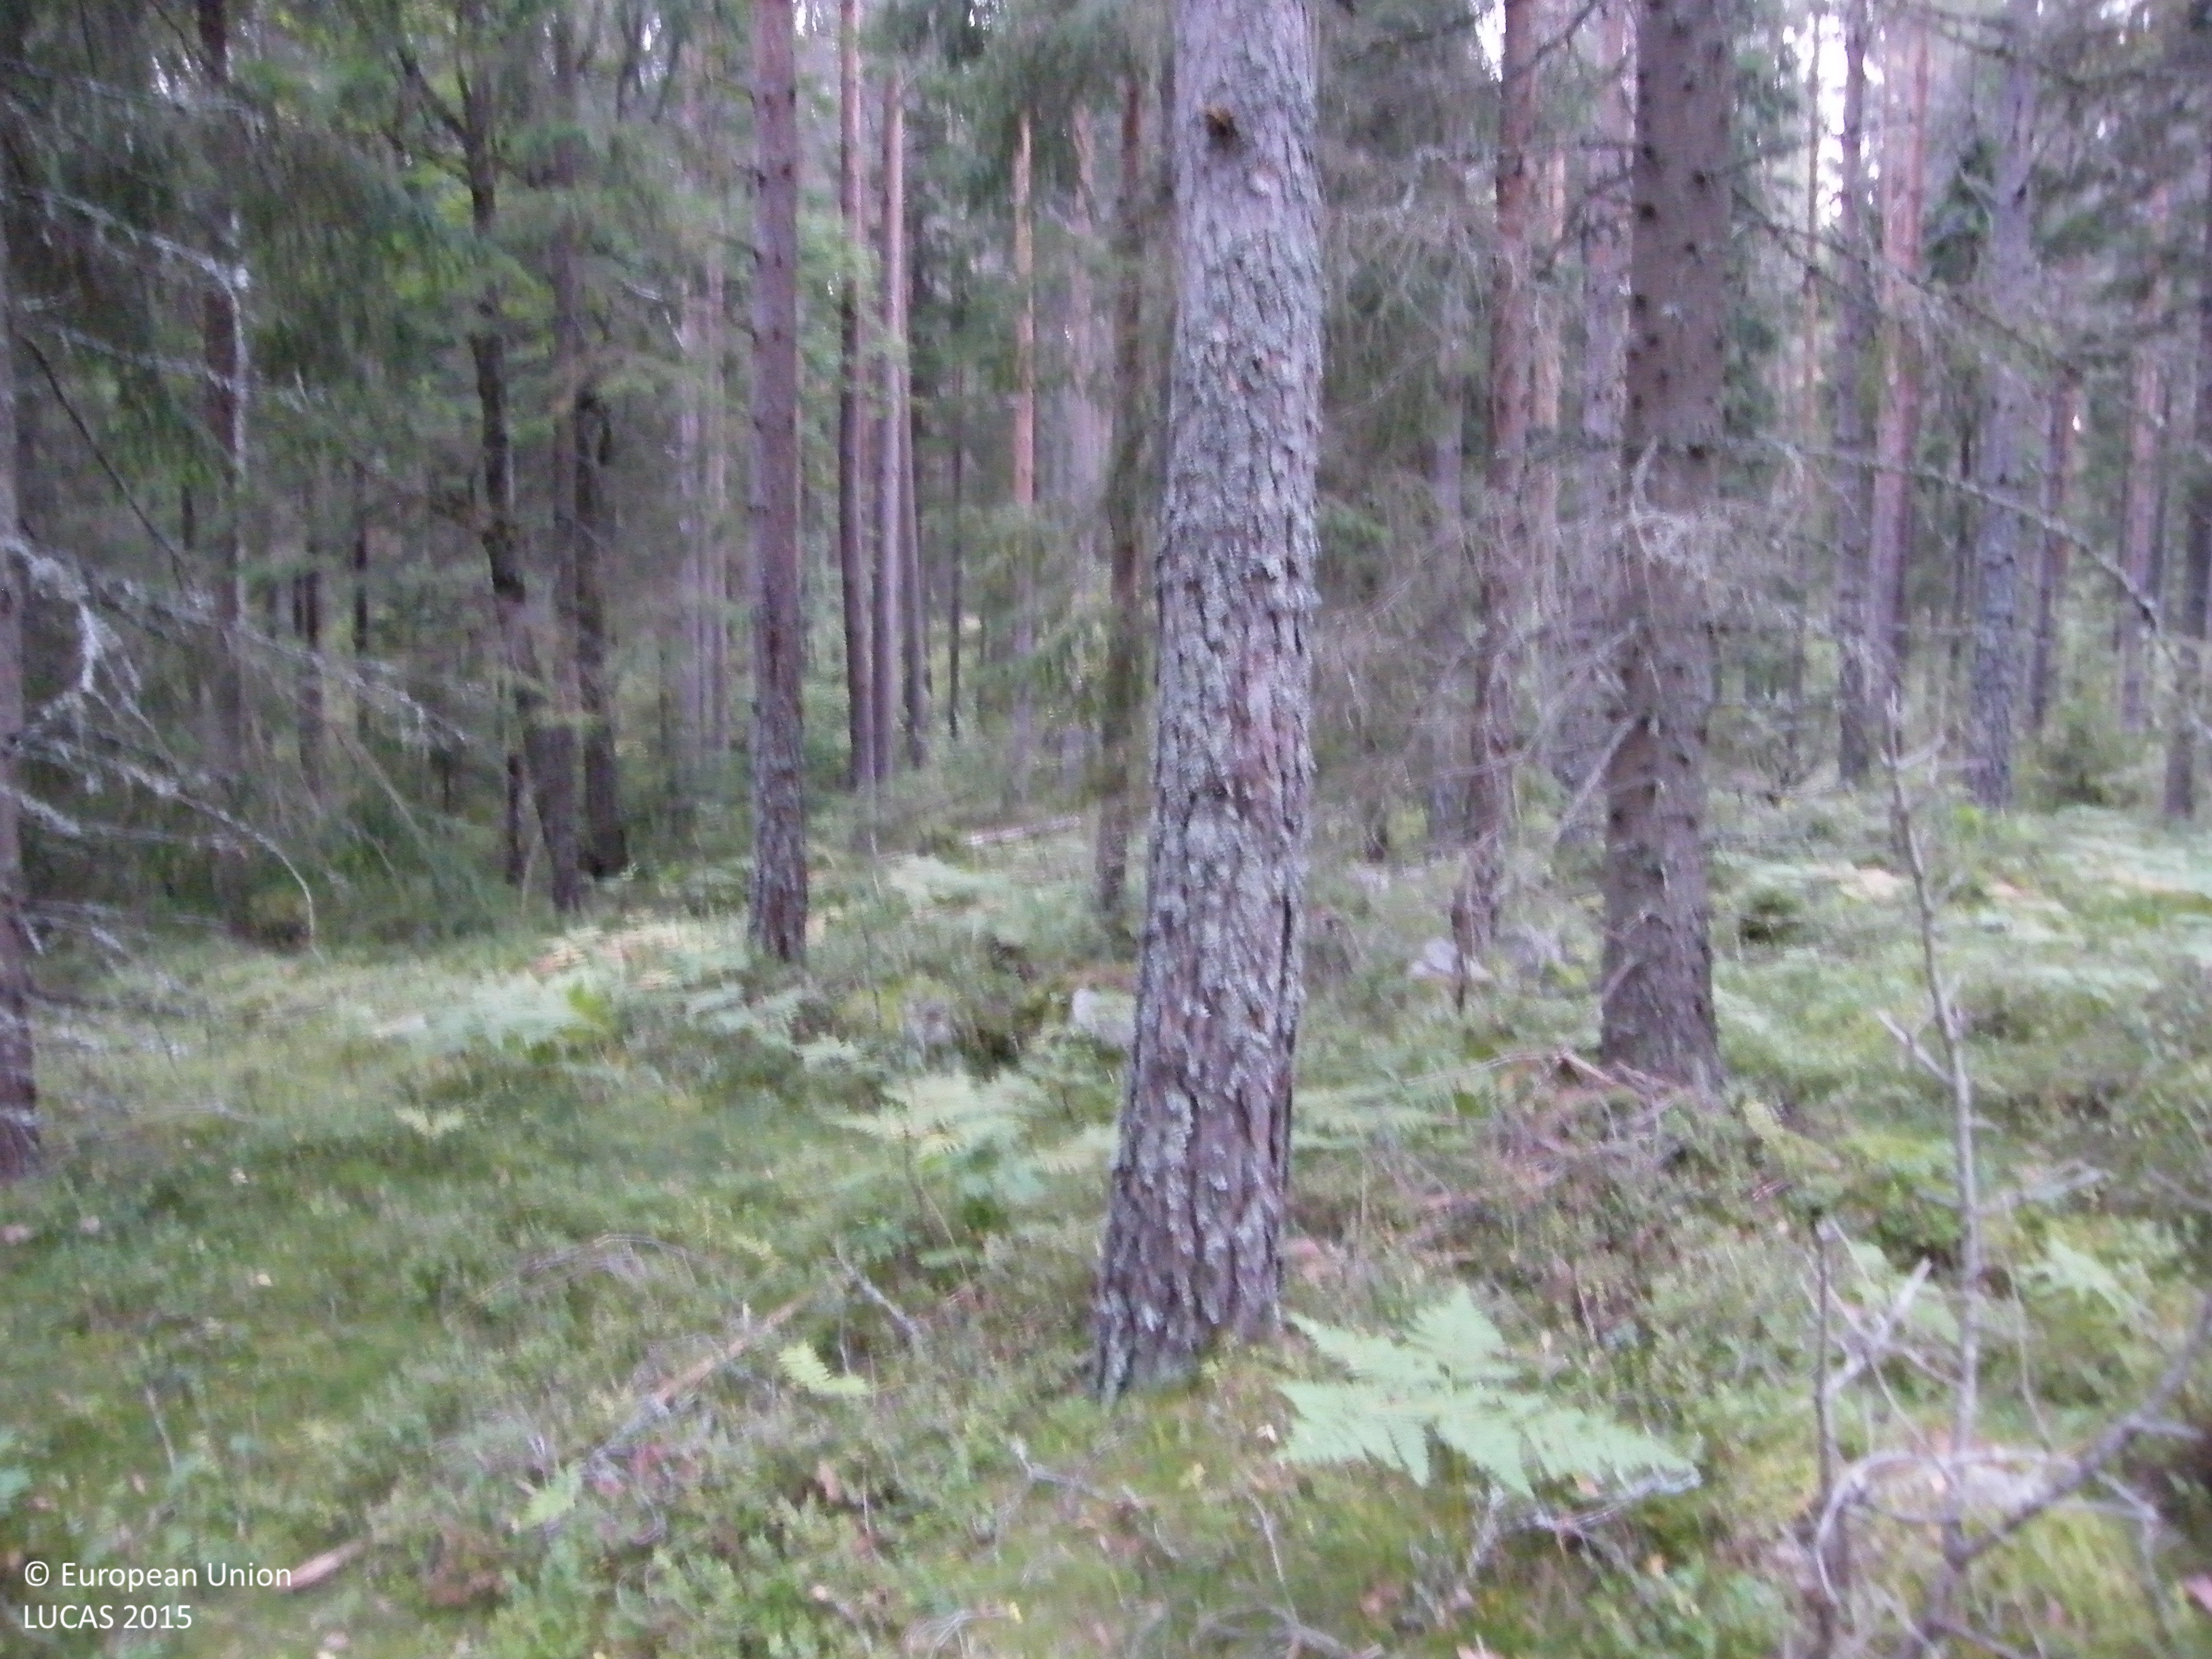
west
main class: Woodland
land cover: Other mixed woodland
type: boreal forest
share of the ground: 50 - 75 %
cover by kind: coniferous forest trees 45 %, broadleaved forest trees 20 %, shrubs 20 %, lichens and mosses 15 %
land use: Forestry
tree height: > 5 m
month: September
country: SE
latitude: 59.7311
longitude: 15.4862
